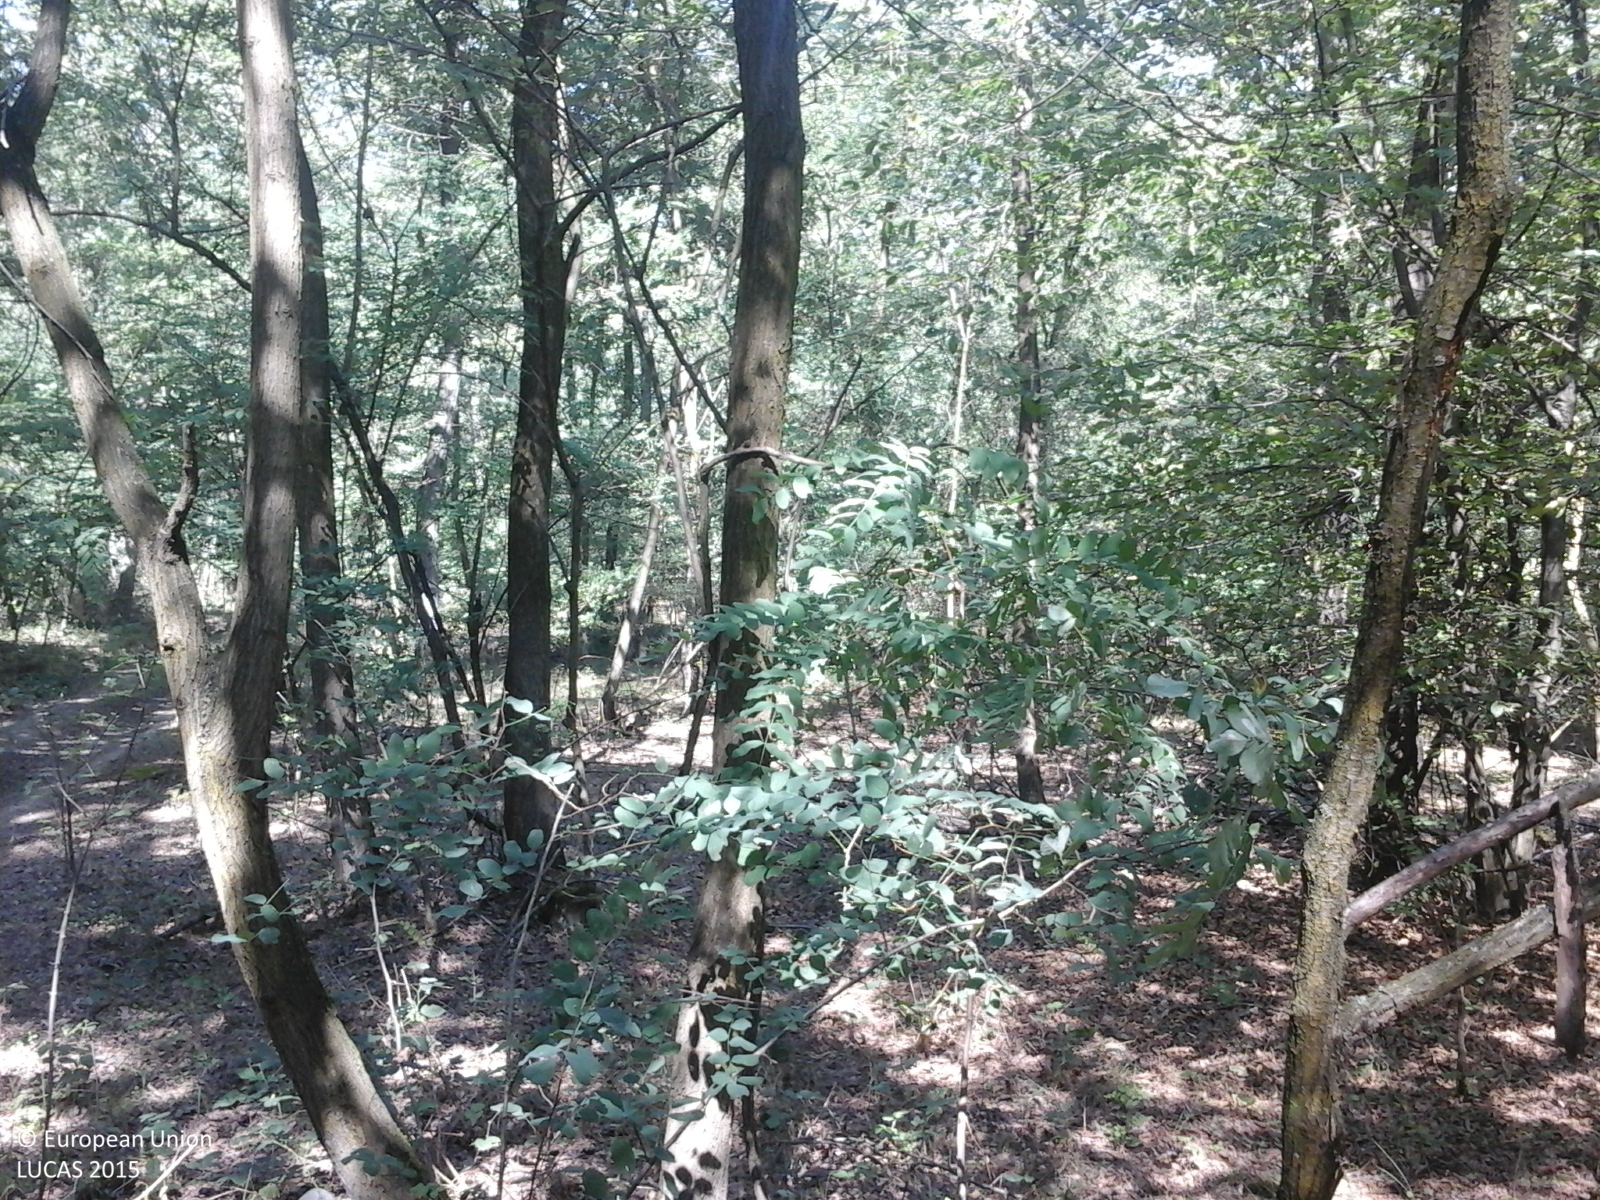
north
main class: Woodland
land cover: Broadleaved woodland
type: acidophilous oak and oak-birch forest
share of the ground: > 75 %
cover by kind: broadleaved forest trees 100 %
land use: Forestry
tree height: > 5 m
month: September
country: RO
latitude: 47.3545
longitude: 22.7293
